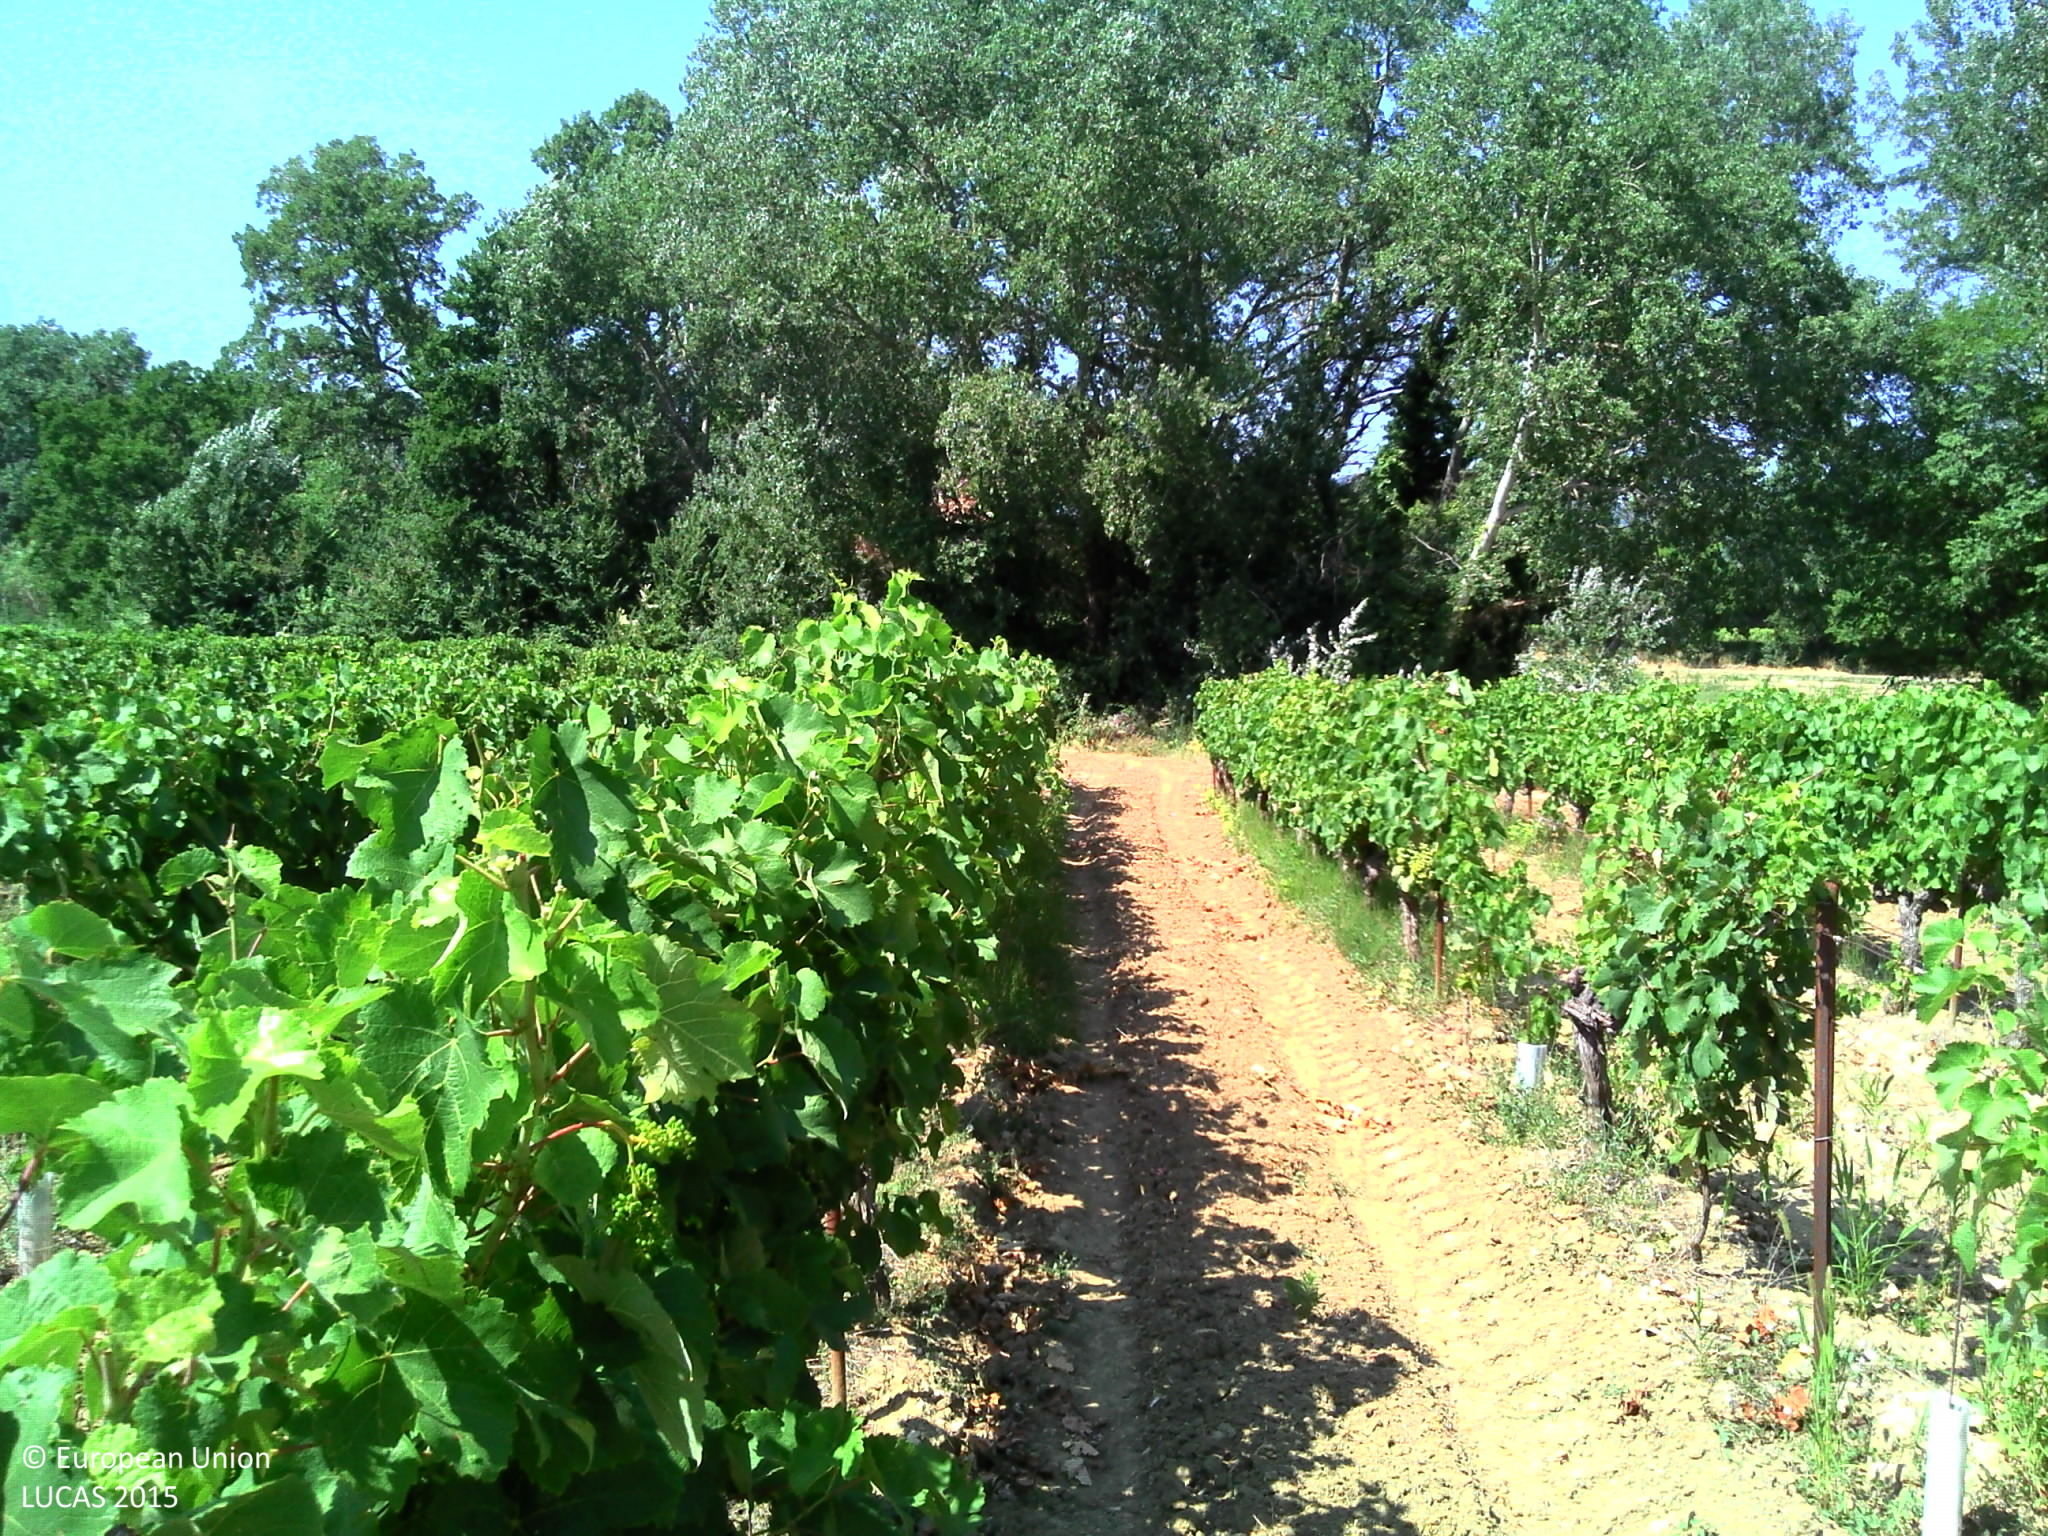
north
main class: Cropland
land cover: Vineyards
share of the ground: 25 - 50 %
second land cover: Other bare soil
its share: > 75 %
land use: Agriculture (excluding fallow land and kitchen gardens)
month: July
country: FR
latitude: 44.0879
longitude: 5.0499
